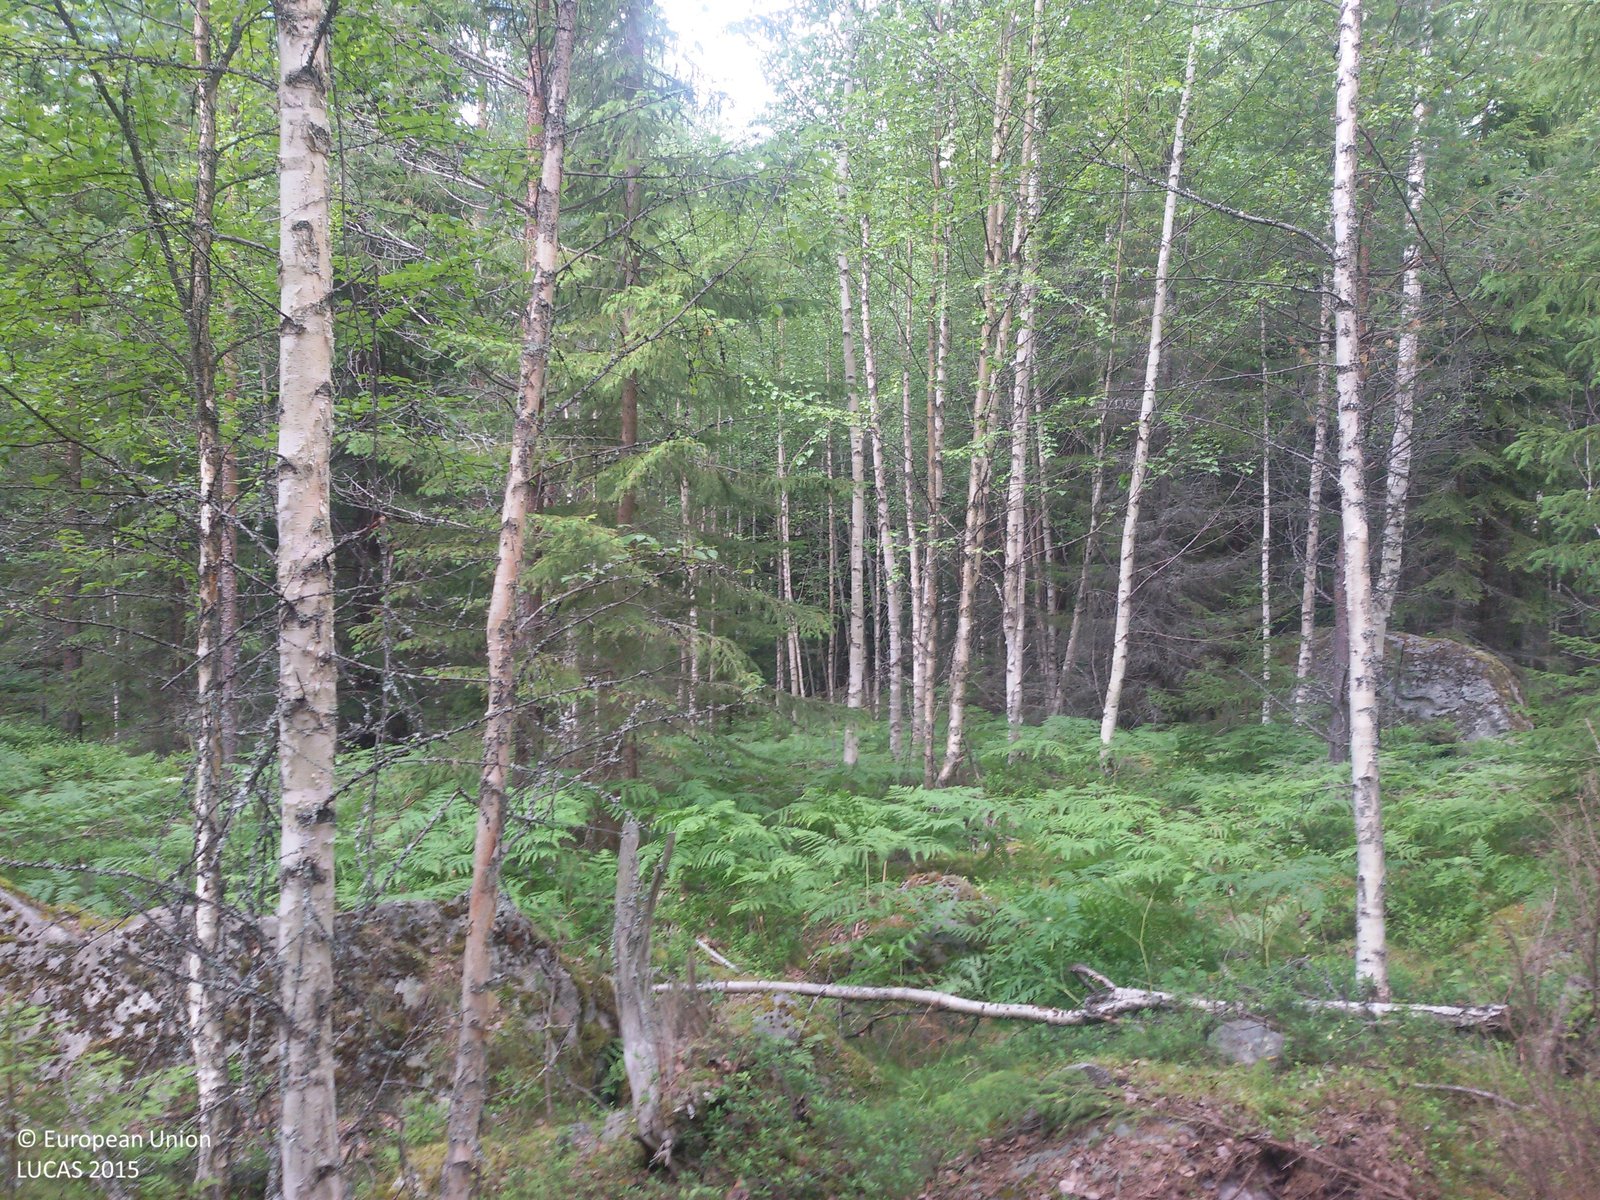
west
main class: Woodland
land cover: Spruce dominated mixed woodland
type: boreal forest
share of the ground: 50 - 75 %
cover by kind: coniferous forest trees 40 %, broadleaved forest trees 35 %, herbaceous plants 15 %, lichens and mosses 10 %
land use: Forestry
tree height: > 5 m
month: July
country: SE
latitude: 60.5506
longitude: 15.2936
